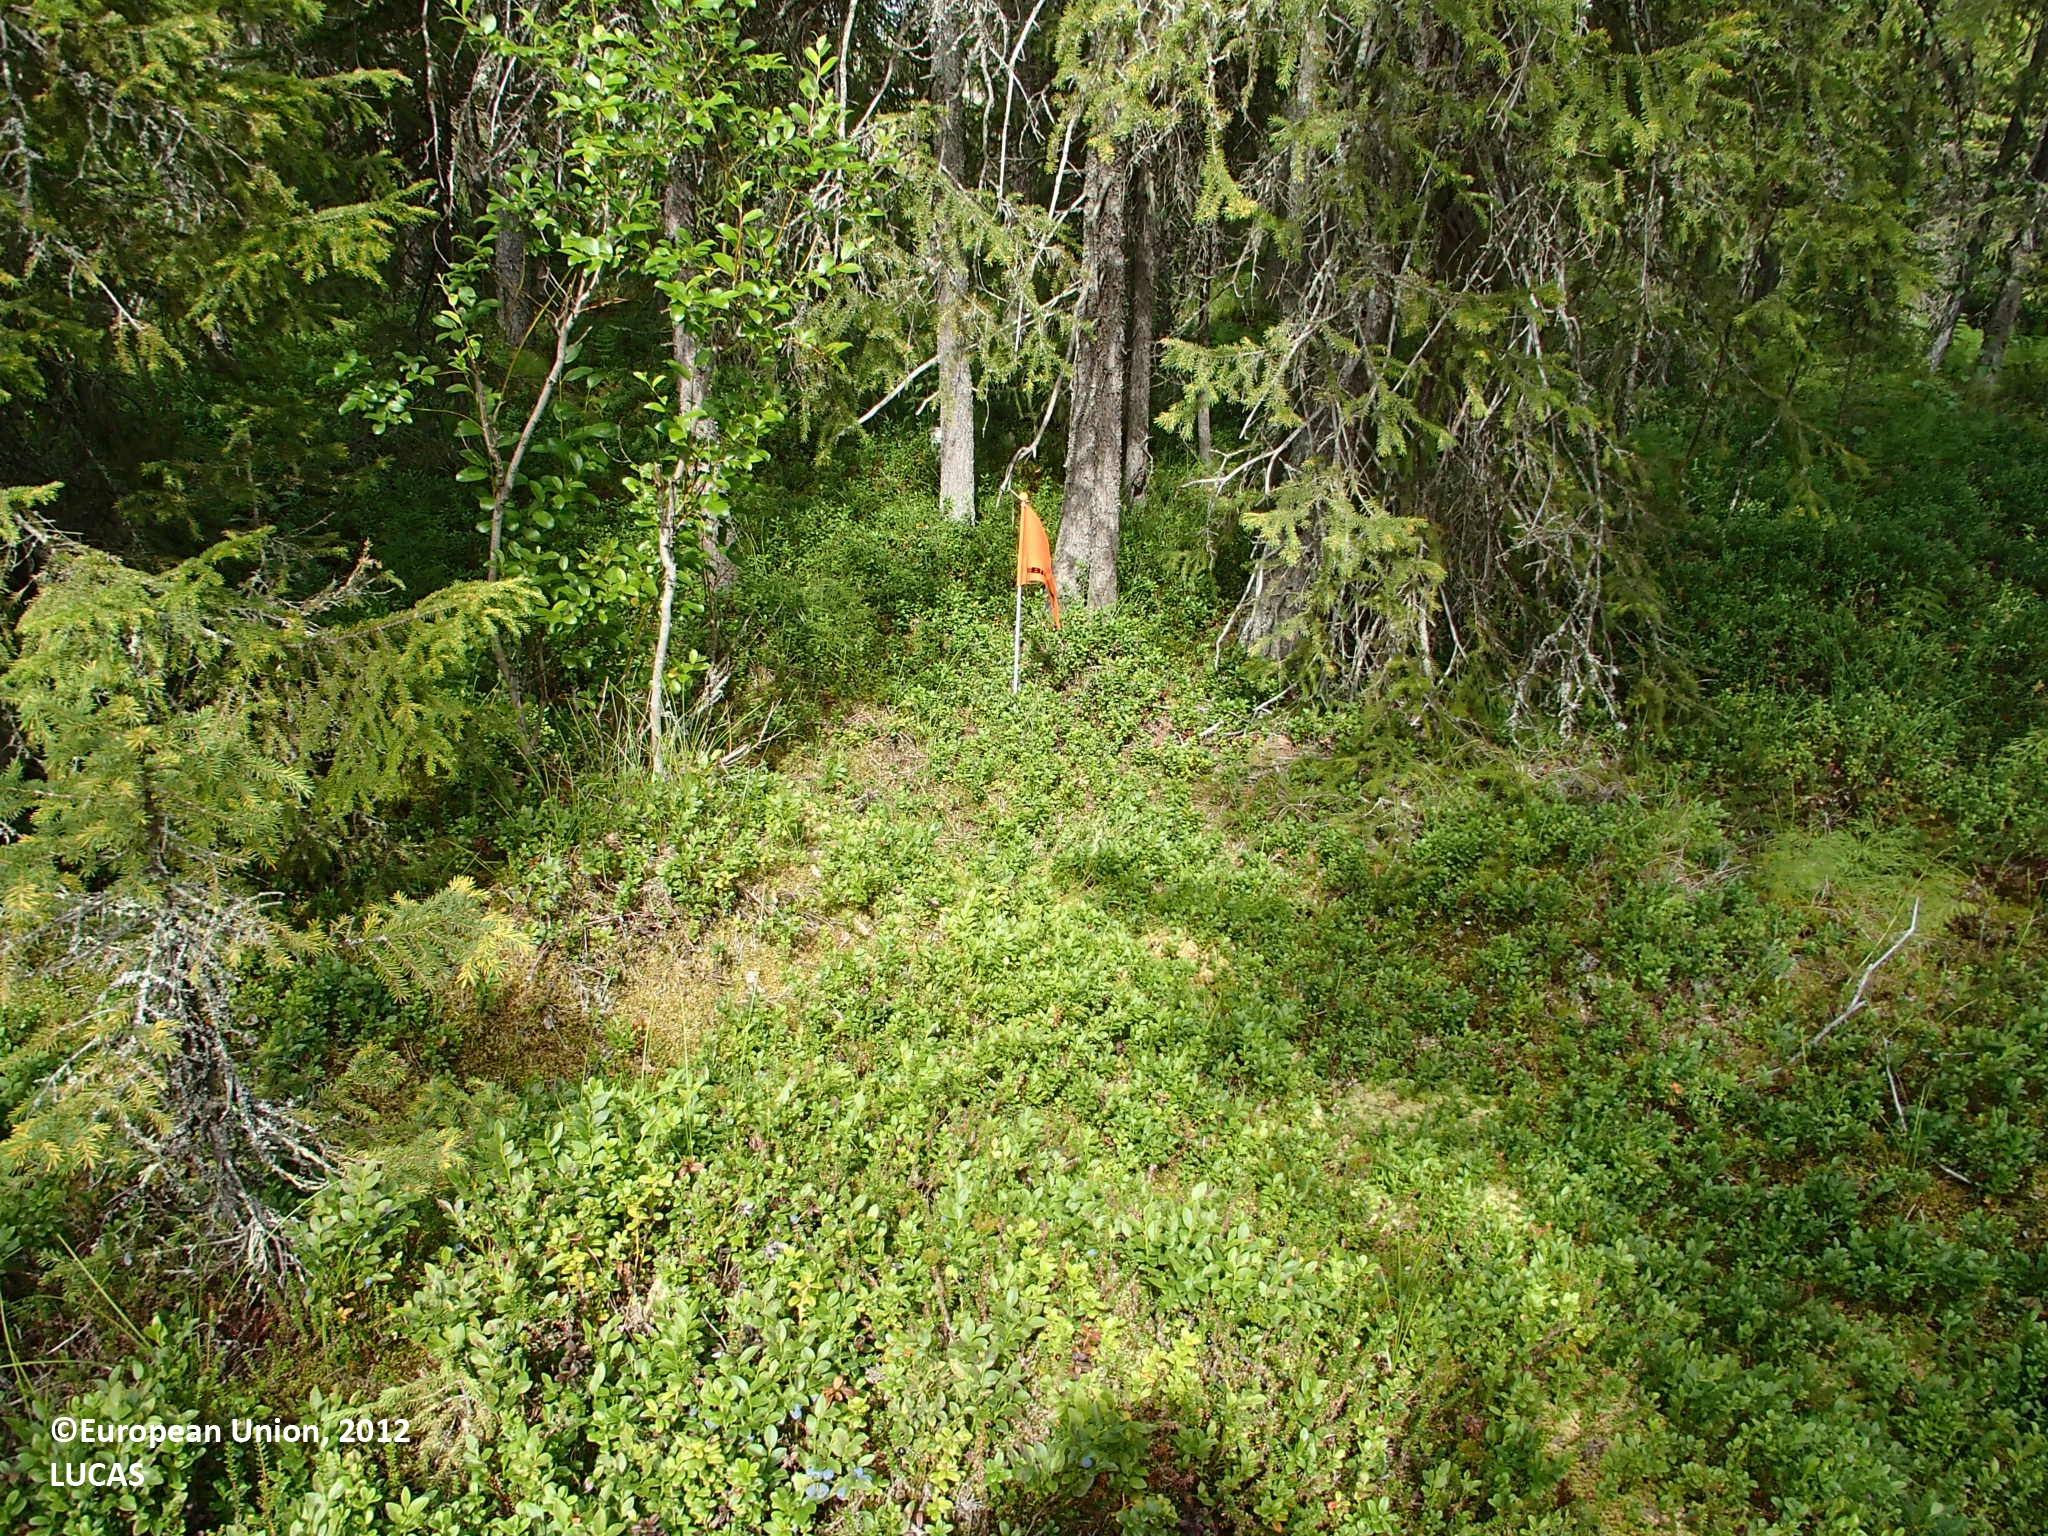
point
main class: Woodland
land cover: Spruce dominated coniferous woodland
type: boreal forest
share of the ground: > 75 %
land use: Forestry
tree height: > 5 m
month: July
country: FI
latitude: 66.4477
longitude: 25.6547
